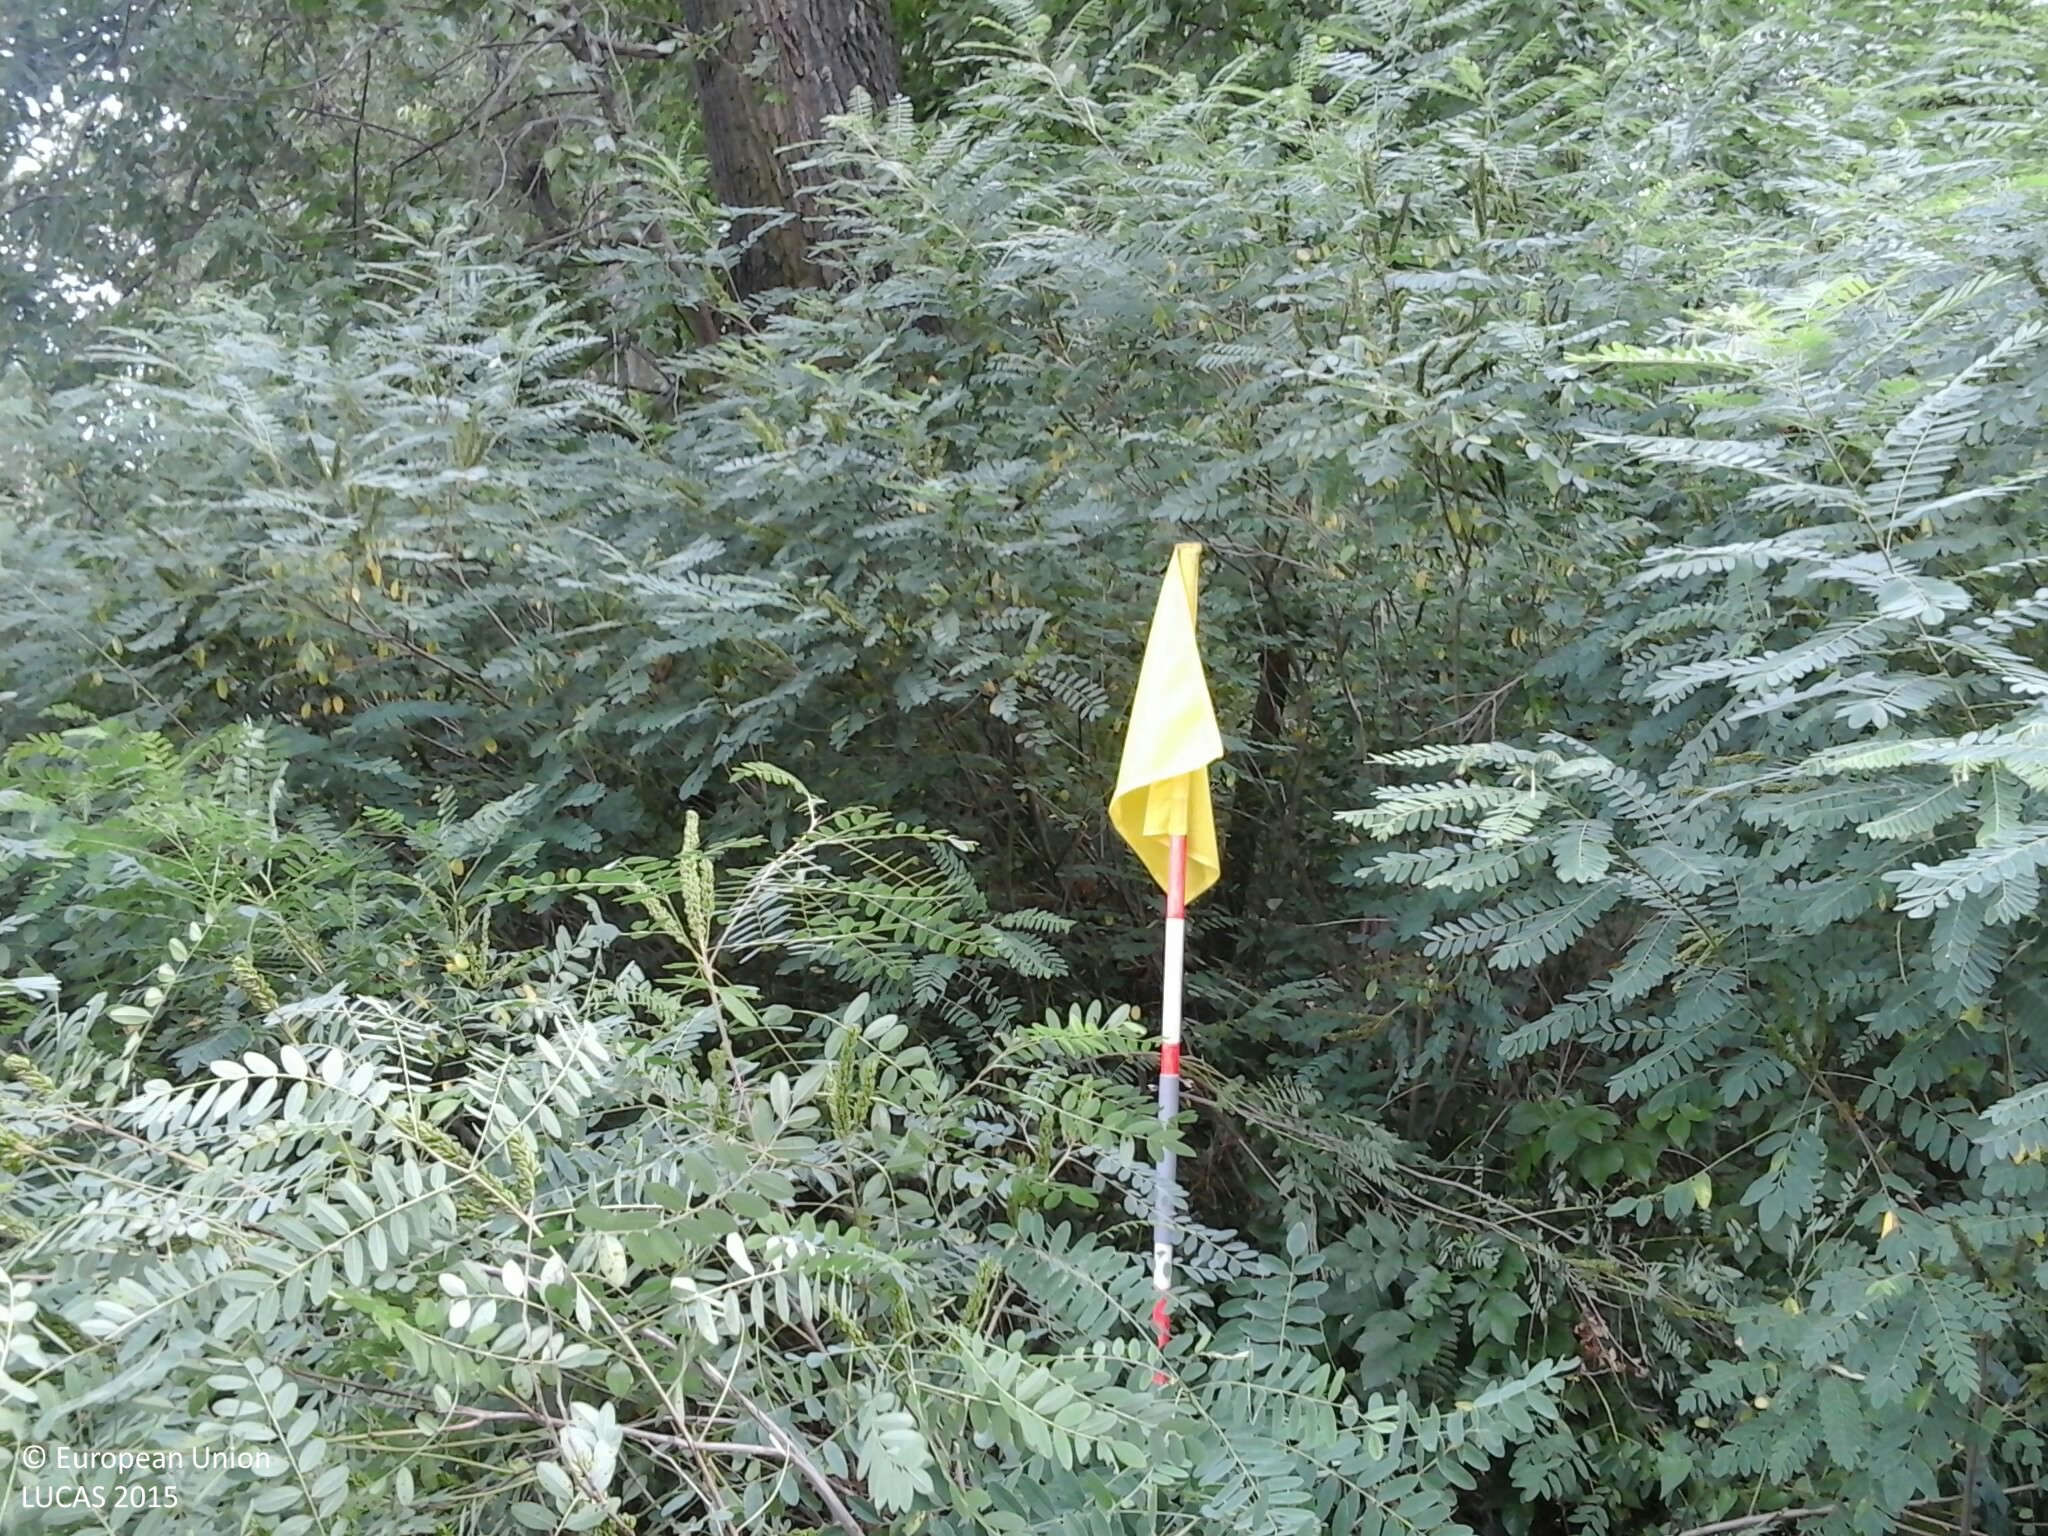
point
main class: Woodland
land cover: Broadleaved woodland
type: floodplain forest
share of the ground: 50 - 75 %
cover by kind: broadleaved forest trees 70 %, shrubs 20 %, herbaceous plants 10 %
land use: Forestry
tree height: > 5 m
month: July
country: HU
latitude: 47.8491
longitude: 21.0370
